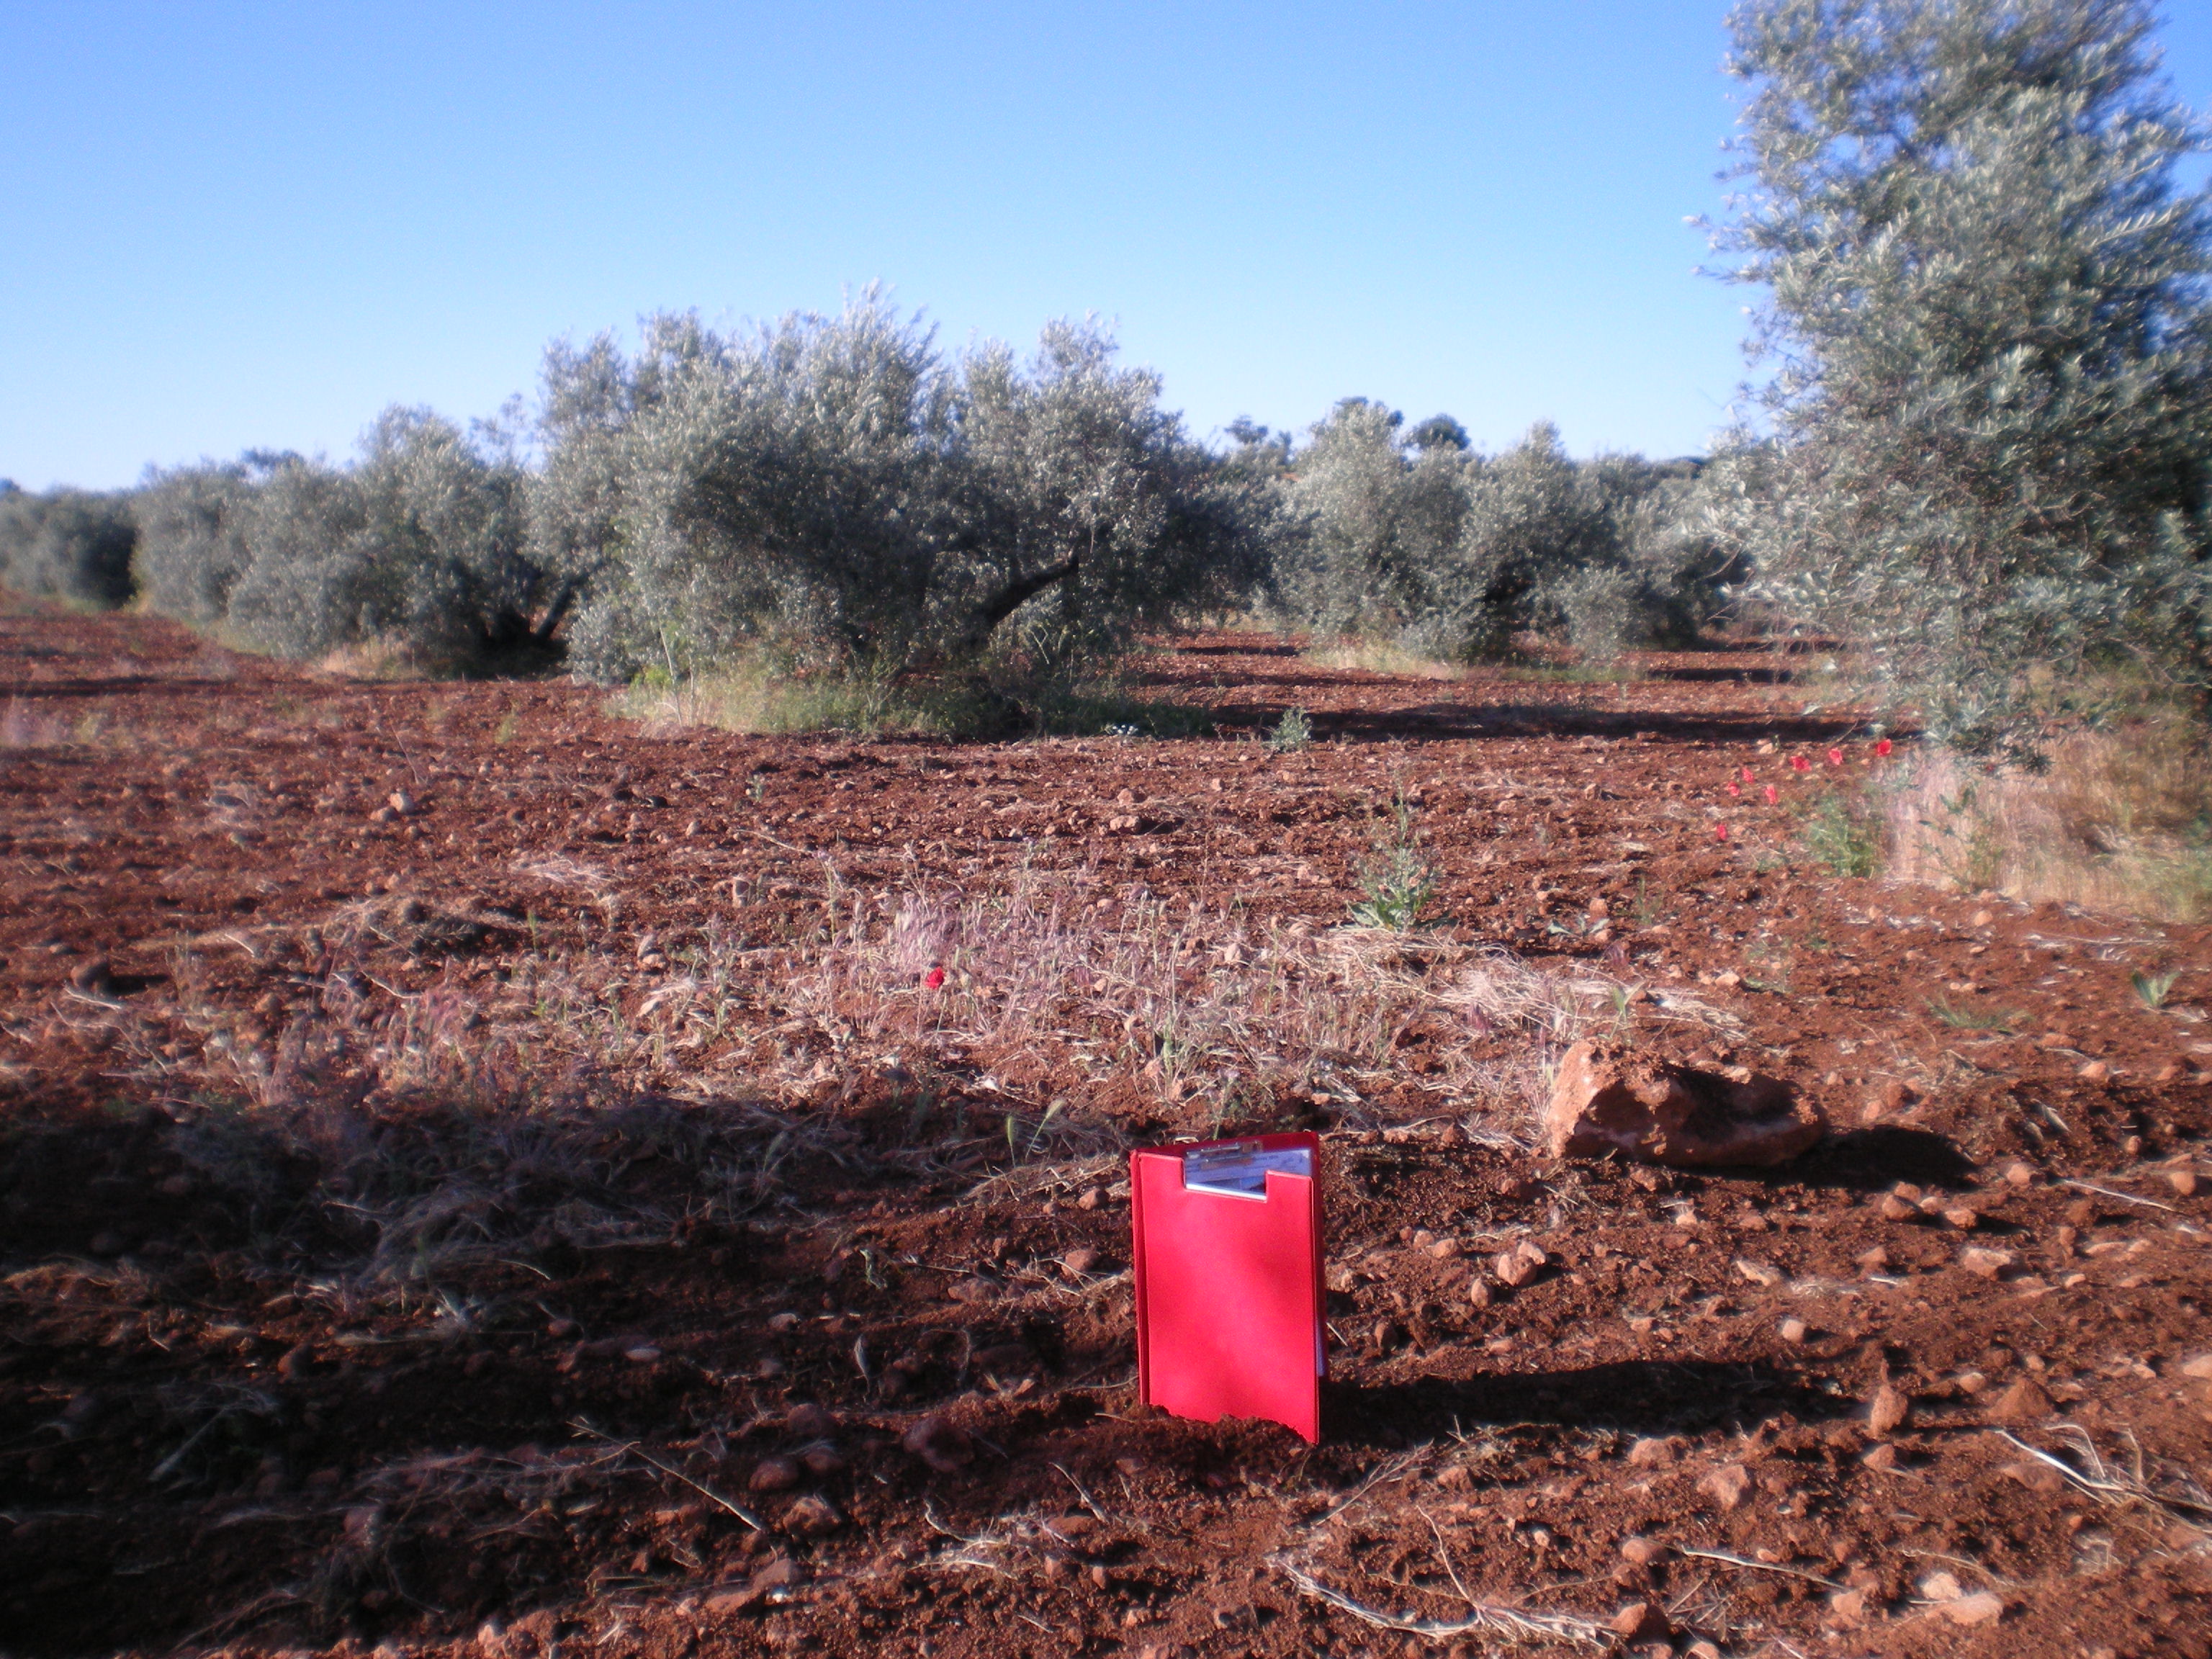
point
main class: Cropland
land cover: Olive groves
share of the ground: 10 - 25 %
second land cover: Other bare soil
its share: > 75 %
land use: Agriculture (excluding fallow land and kitchen gardens)
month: May
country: ES
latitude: 38.6746
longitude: -2.9362
